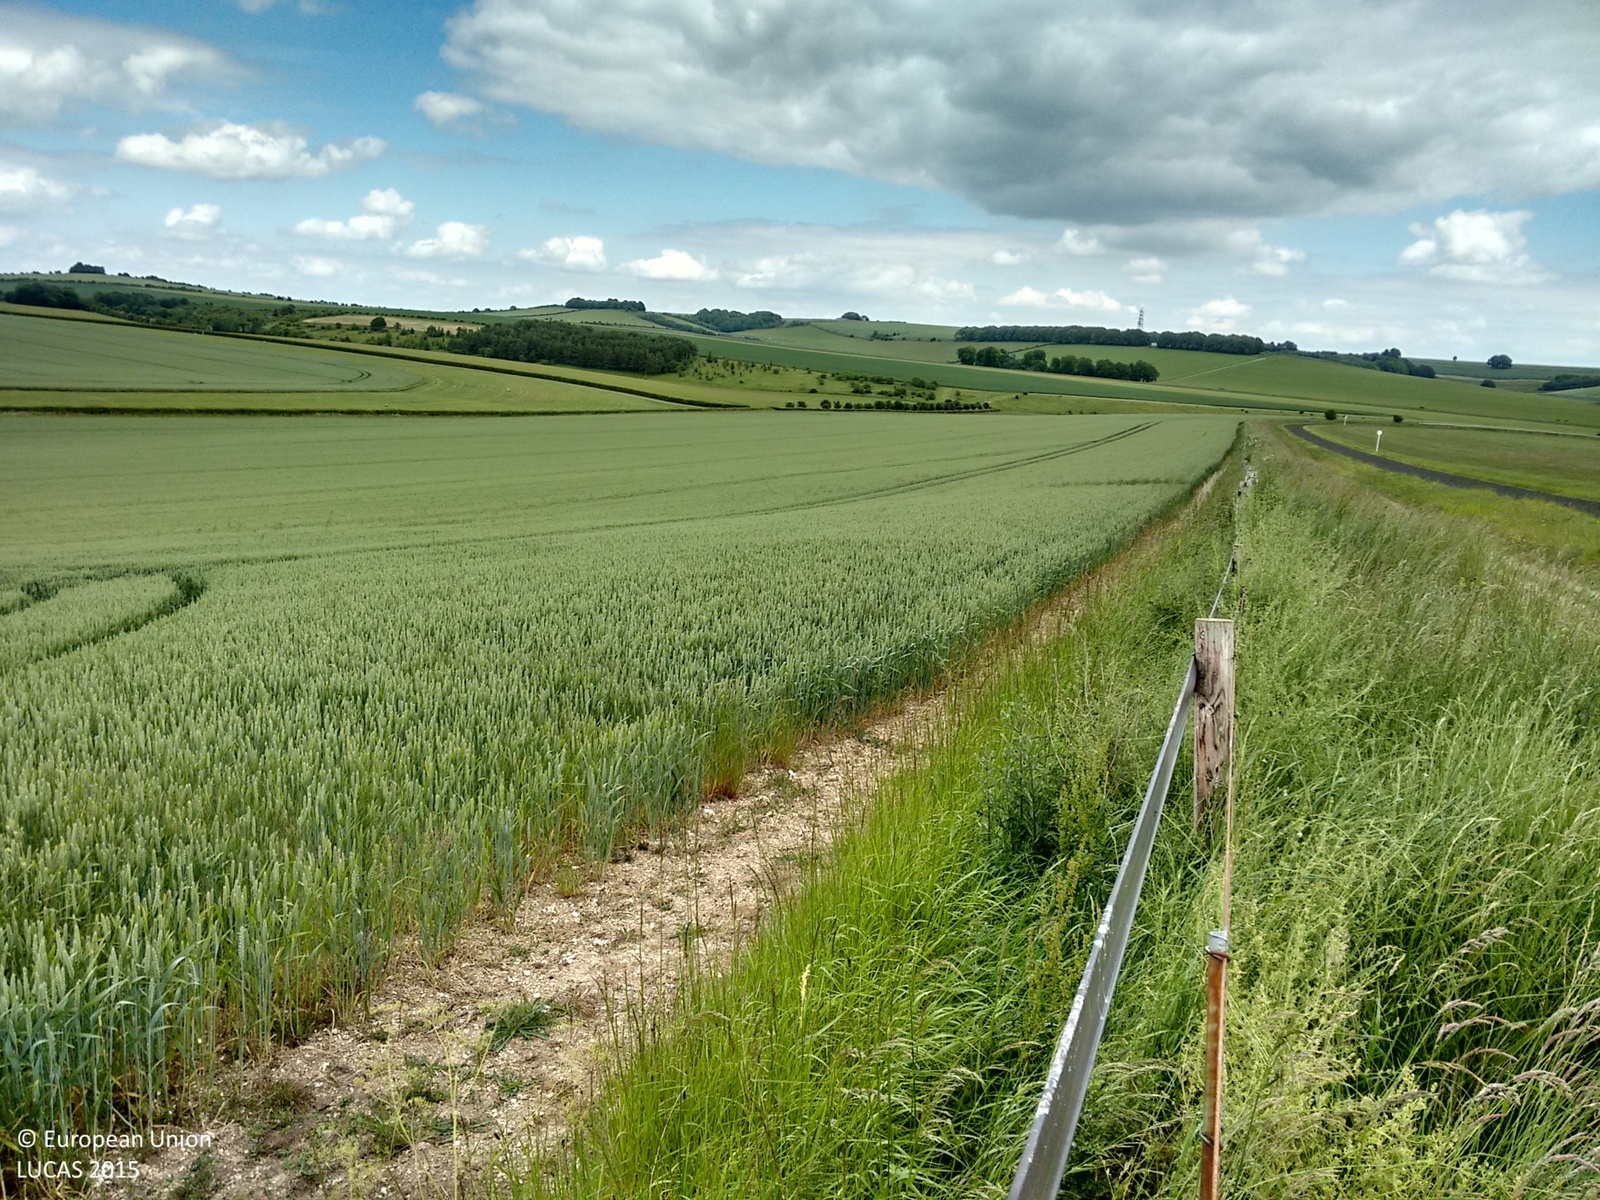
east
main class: Cropland
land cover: Common wheat
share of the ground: > 75 %
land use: Agriculture (excluding fallow land and kitchen gardens)
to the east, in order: Common wheat
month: June
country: GB
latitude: 51.5574
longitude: -1.5475
